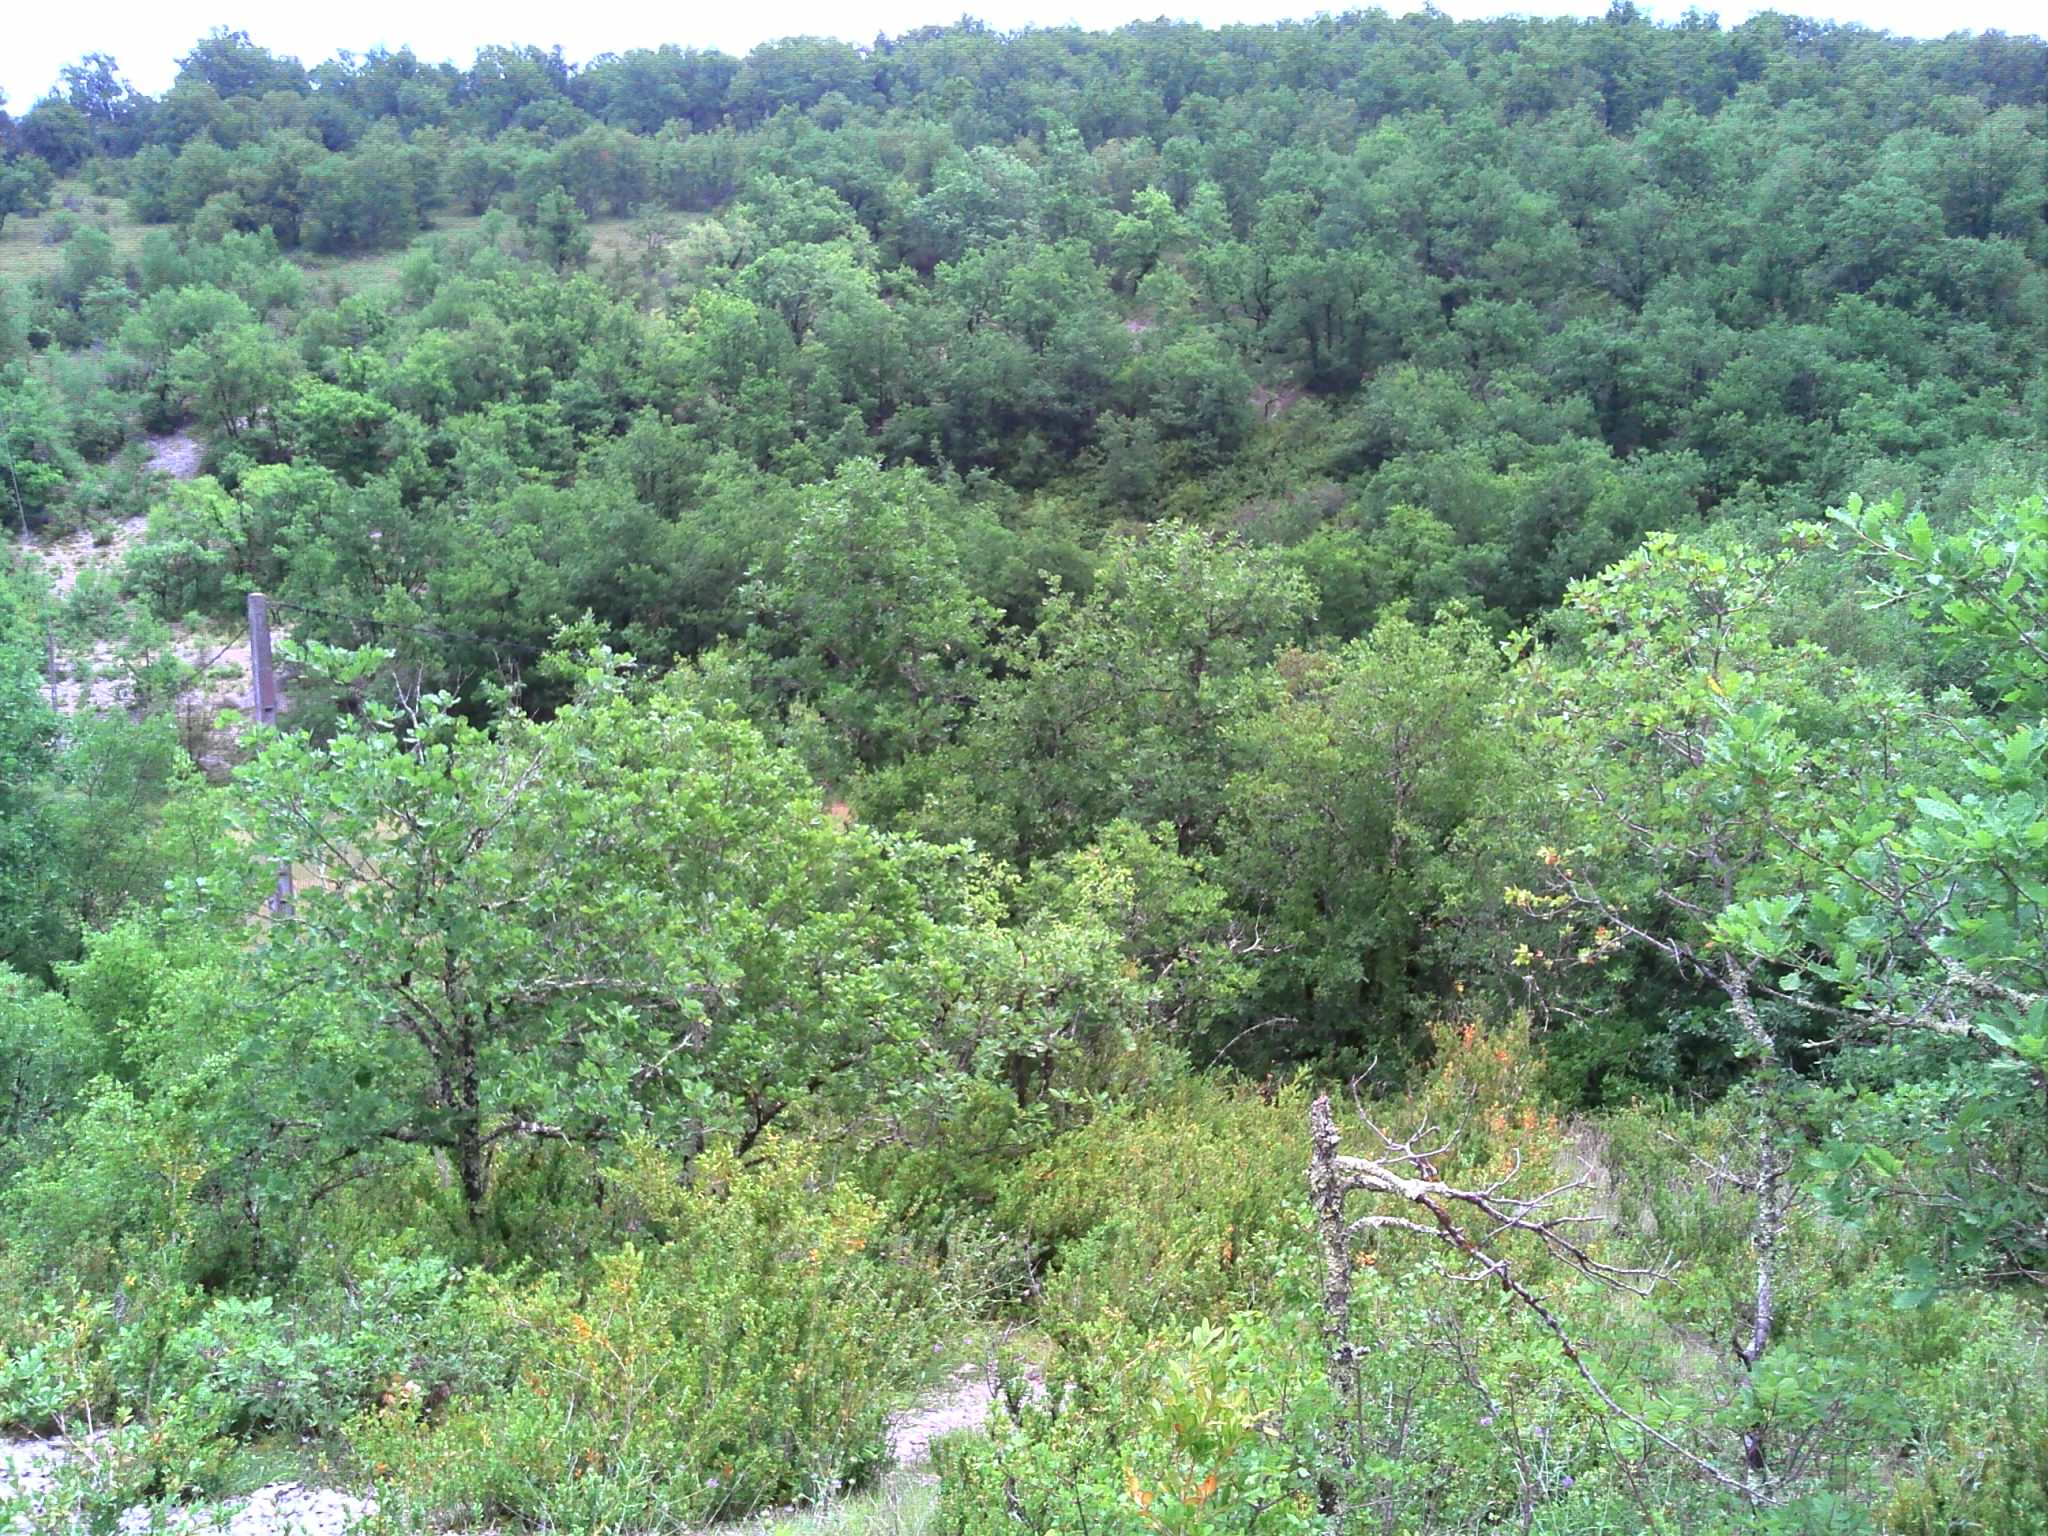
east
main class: Woodland
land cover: Broadleaved woodland
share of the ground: > 75 %
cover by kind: broadleaved forest trees 95 %, herbaceous plants 5 %
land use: Semi-natural and natural areas not in use
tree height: < 5 m
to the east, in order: Broadleaved woodland; Electric lines; Shruby margins; Mixed cereals for fodder; Broadleaved woodland; Fences; Broadleaved woodland; Grassland with sparse tree/shrub cover
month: June
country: FR
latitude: 44.4378
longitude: 1.5182
